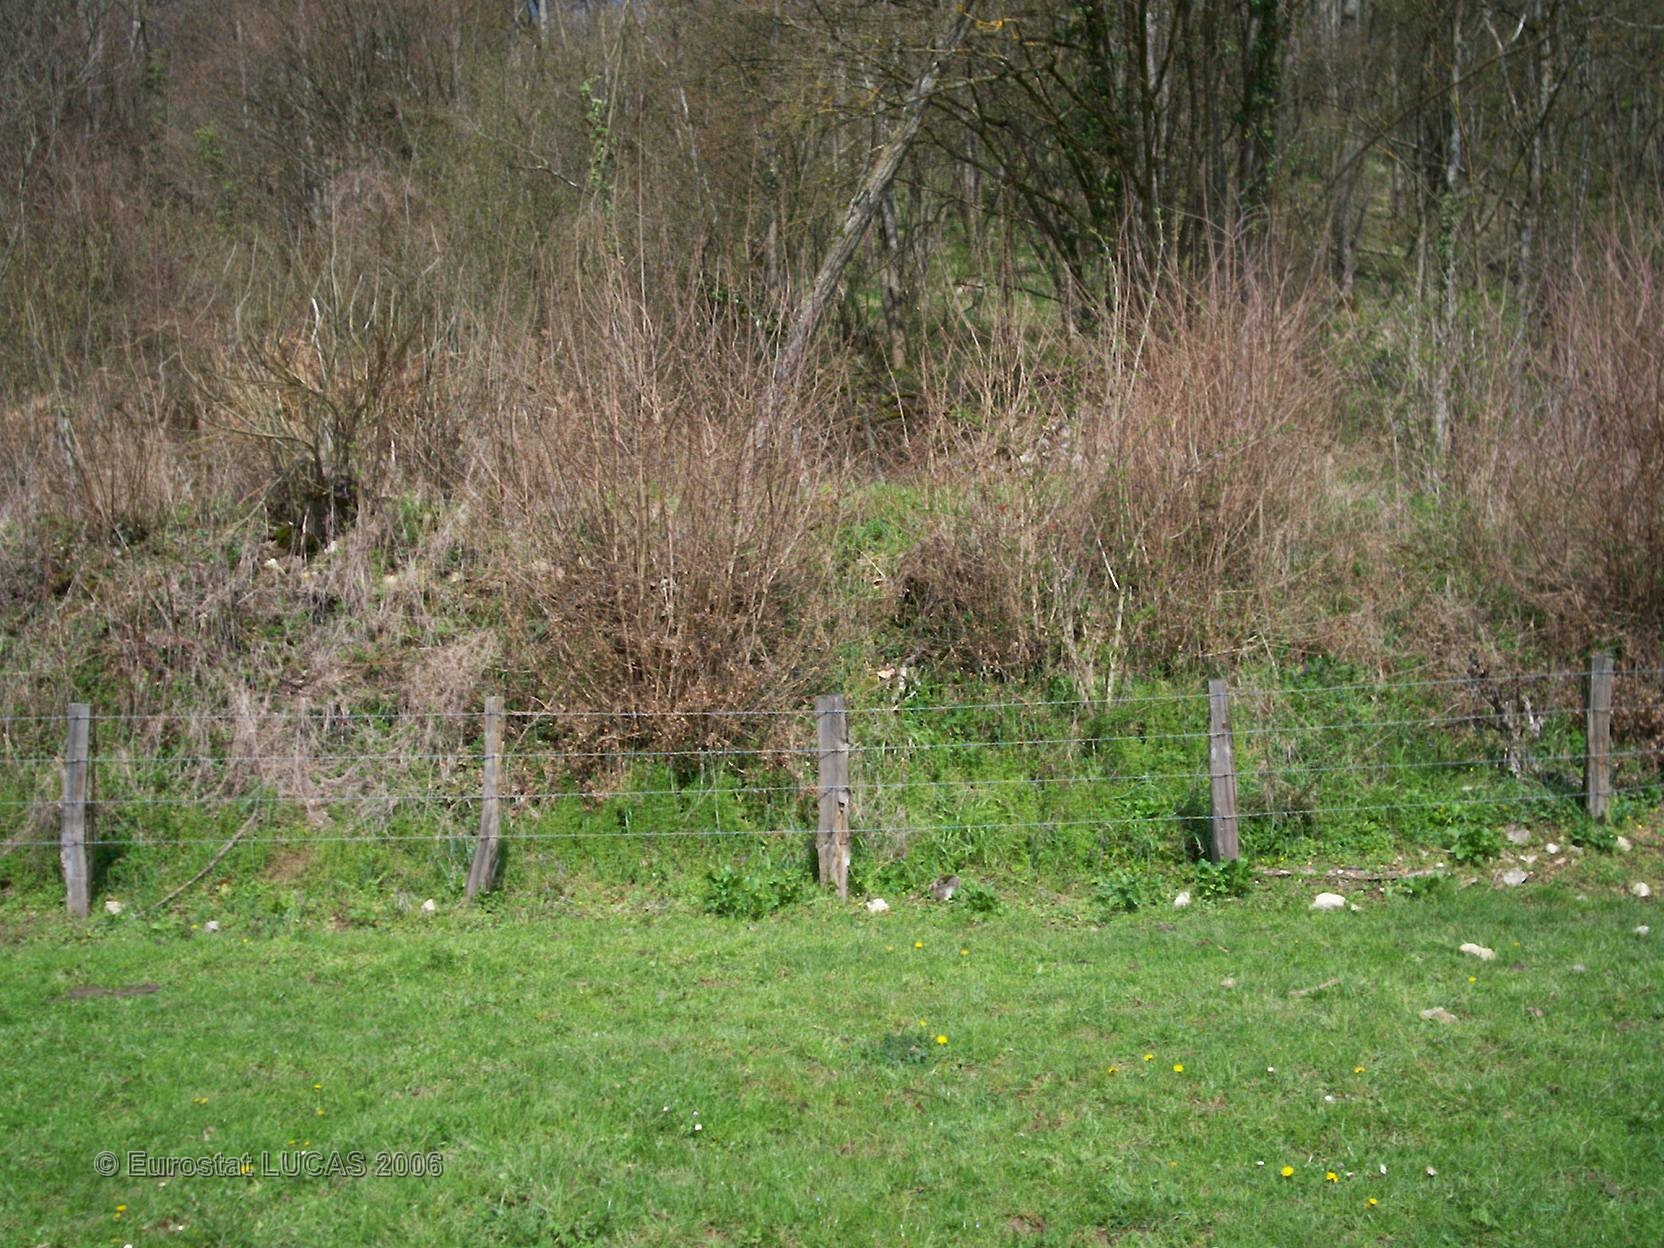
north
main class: Grassland
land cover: Grassland with sparse tree/shrub cover
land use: Agriculture (excluding fallow land and kitchen gardens)
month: April
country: FR
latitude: 46.2231
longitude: 4.0763
